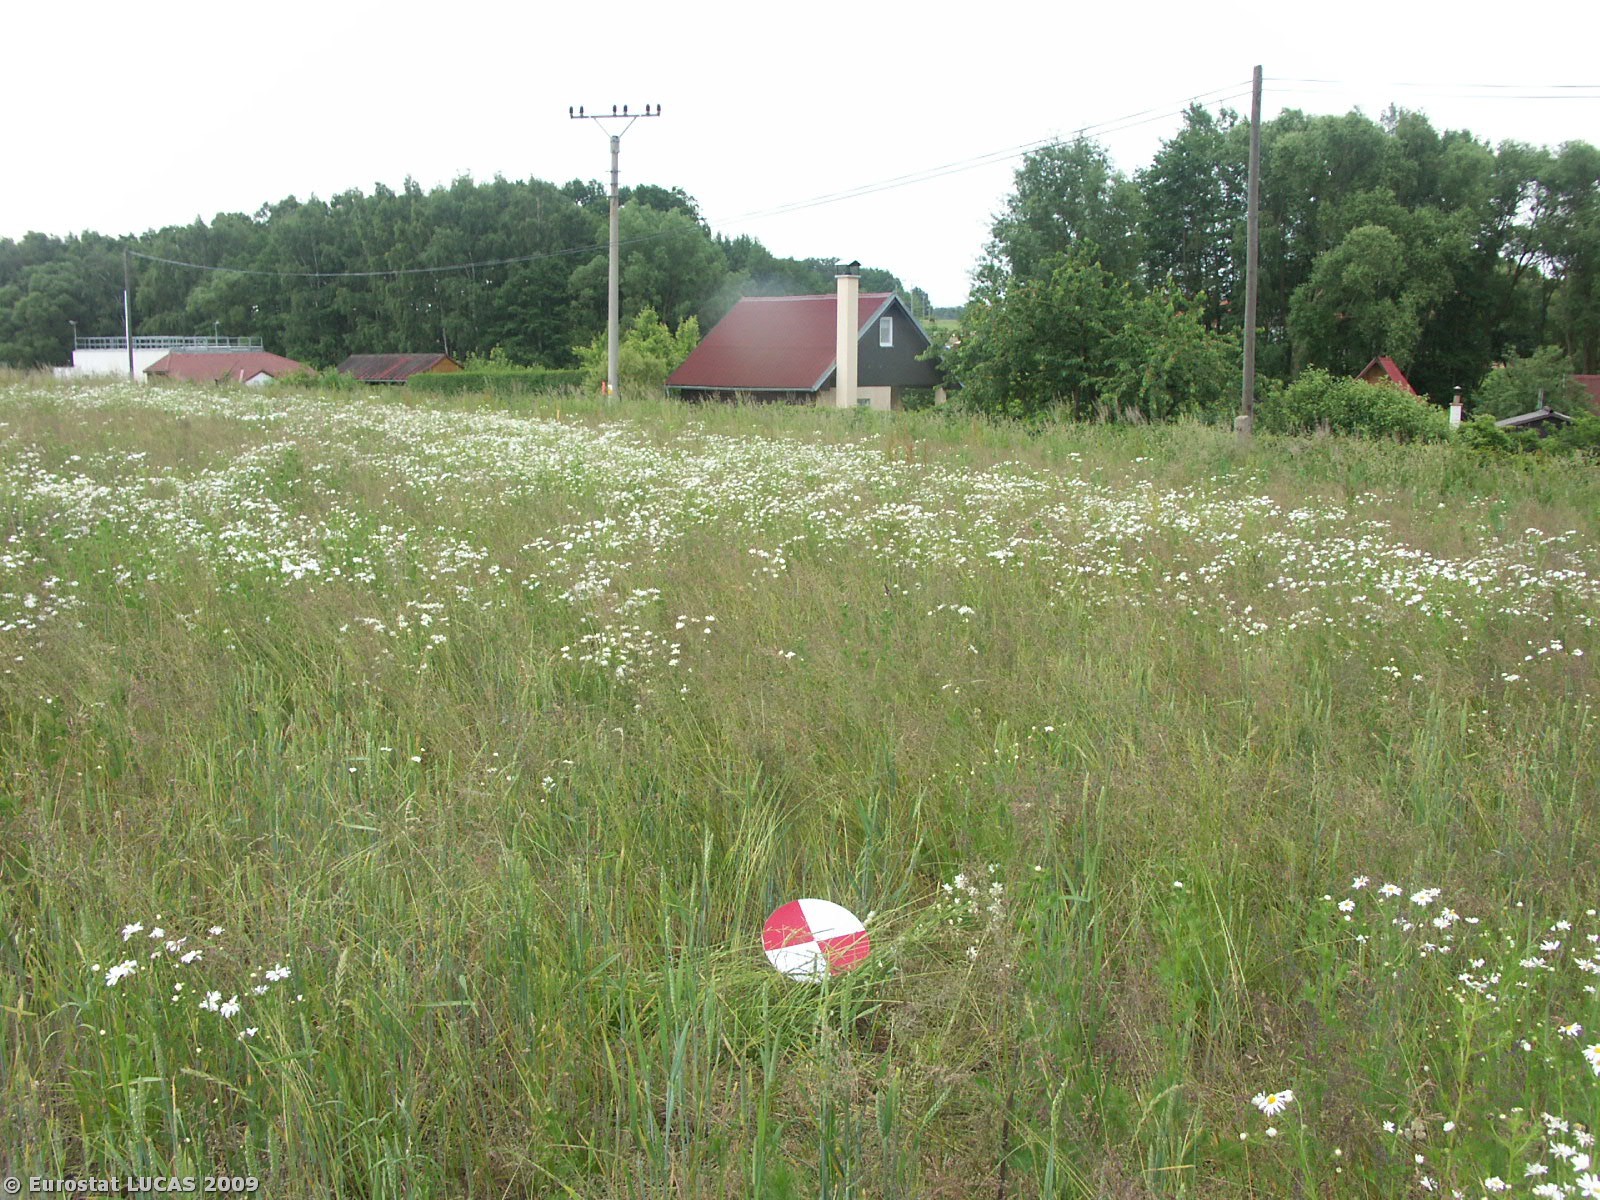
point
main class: Grassland
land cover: Spontaneously vegetated surfaces
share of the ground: > 75 %
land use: Fallow land
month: June
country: CZ
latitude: 48.9373
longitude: 14.6292
